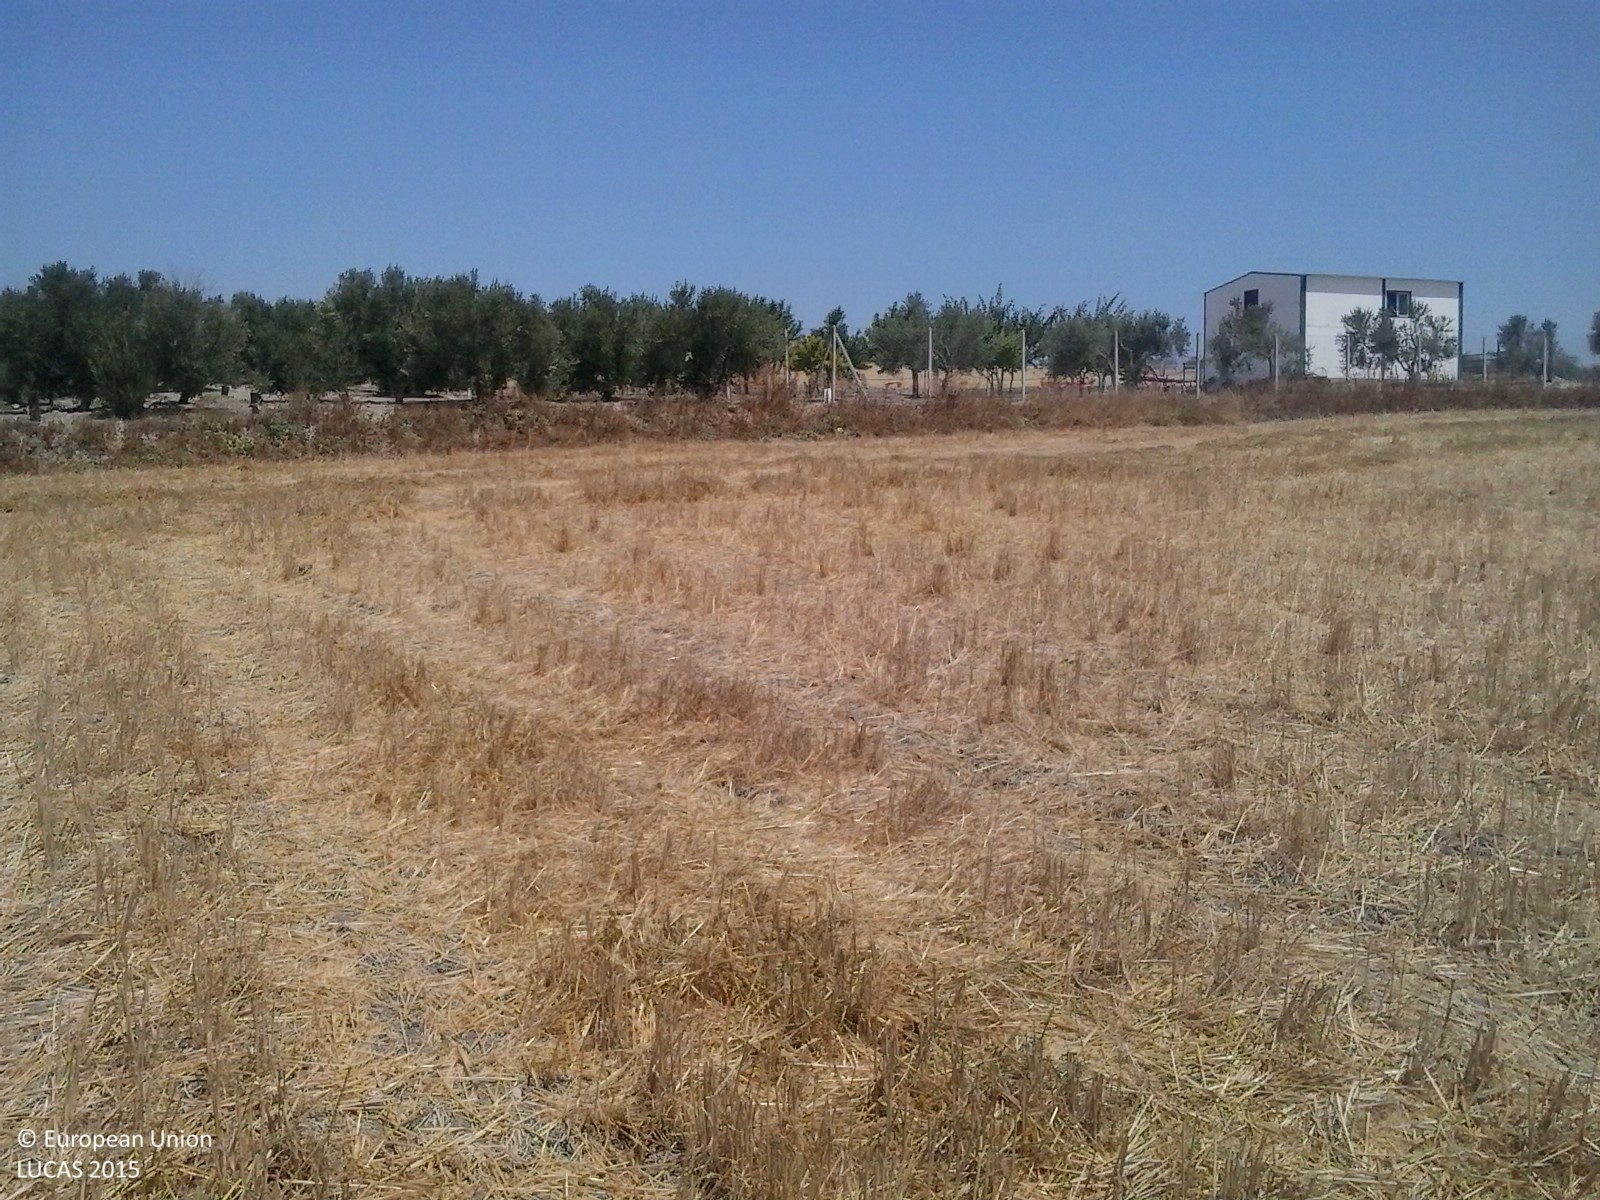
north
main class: Cropland
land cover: Common wheat
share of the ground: < 10 %
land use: Agriculture (excluding fallow land and kitchen gardens)
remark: Harvested field
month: July
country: ES
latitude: 36.9341
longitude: -6.0142
